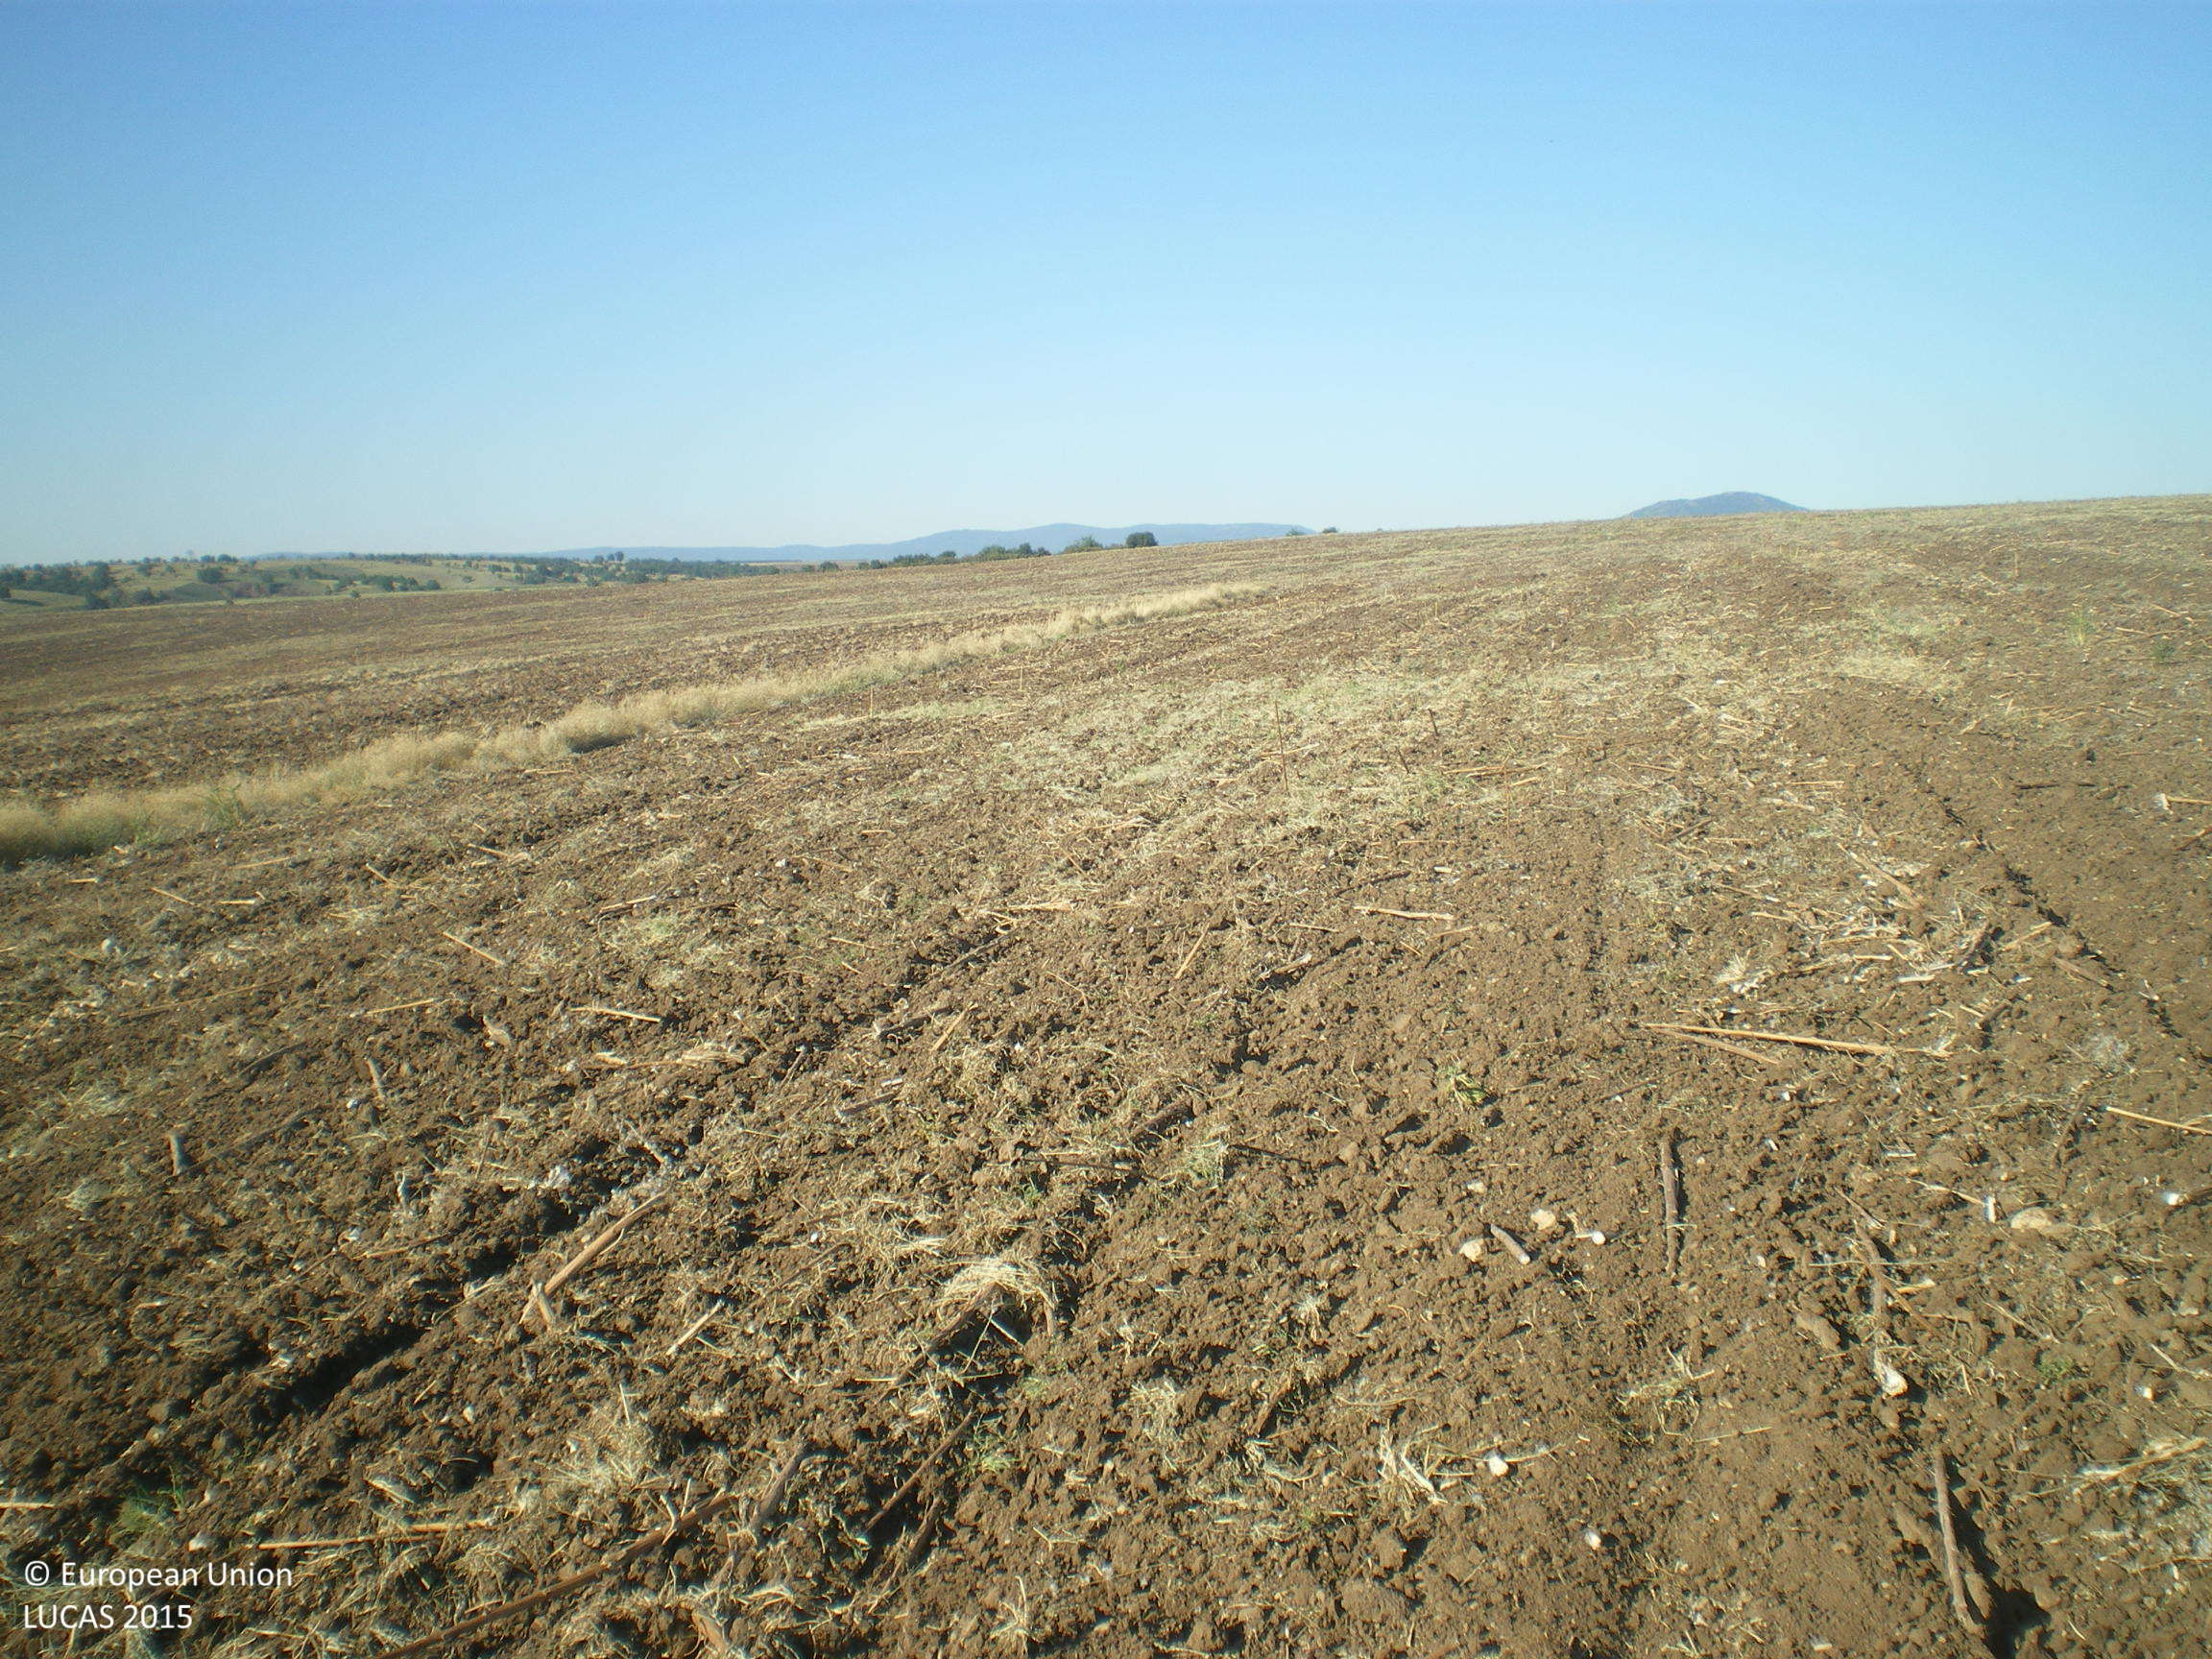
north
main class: Cropland
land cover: Sunflower
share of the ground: < 10 %
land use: Agriculture (excluding fallow land and kitchen gardens)
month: September
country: BG
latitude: 41.8205
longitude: 26.2951
